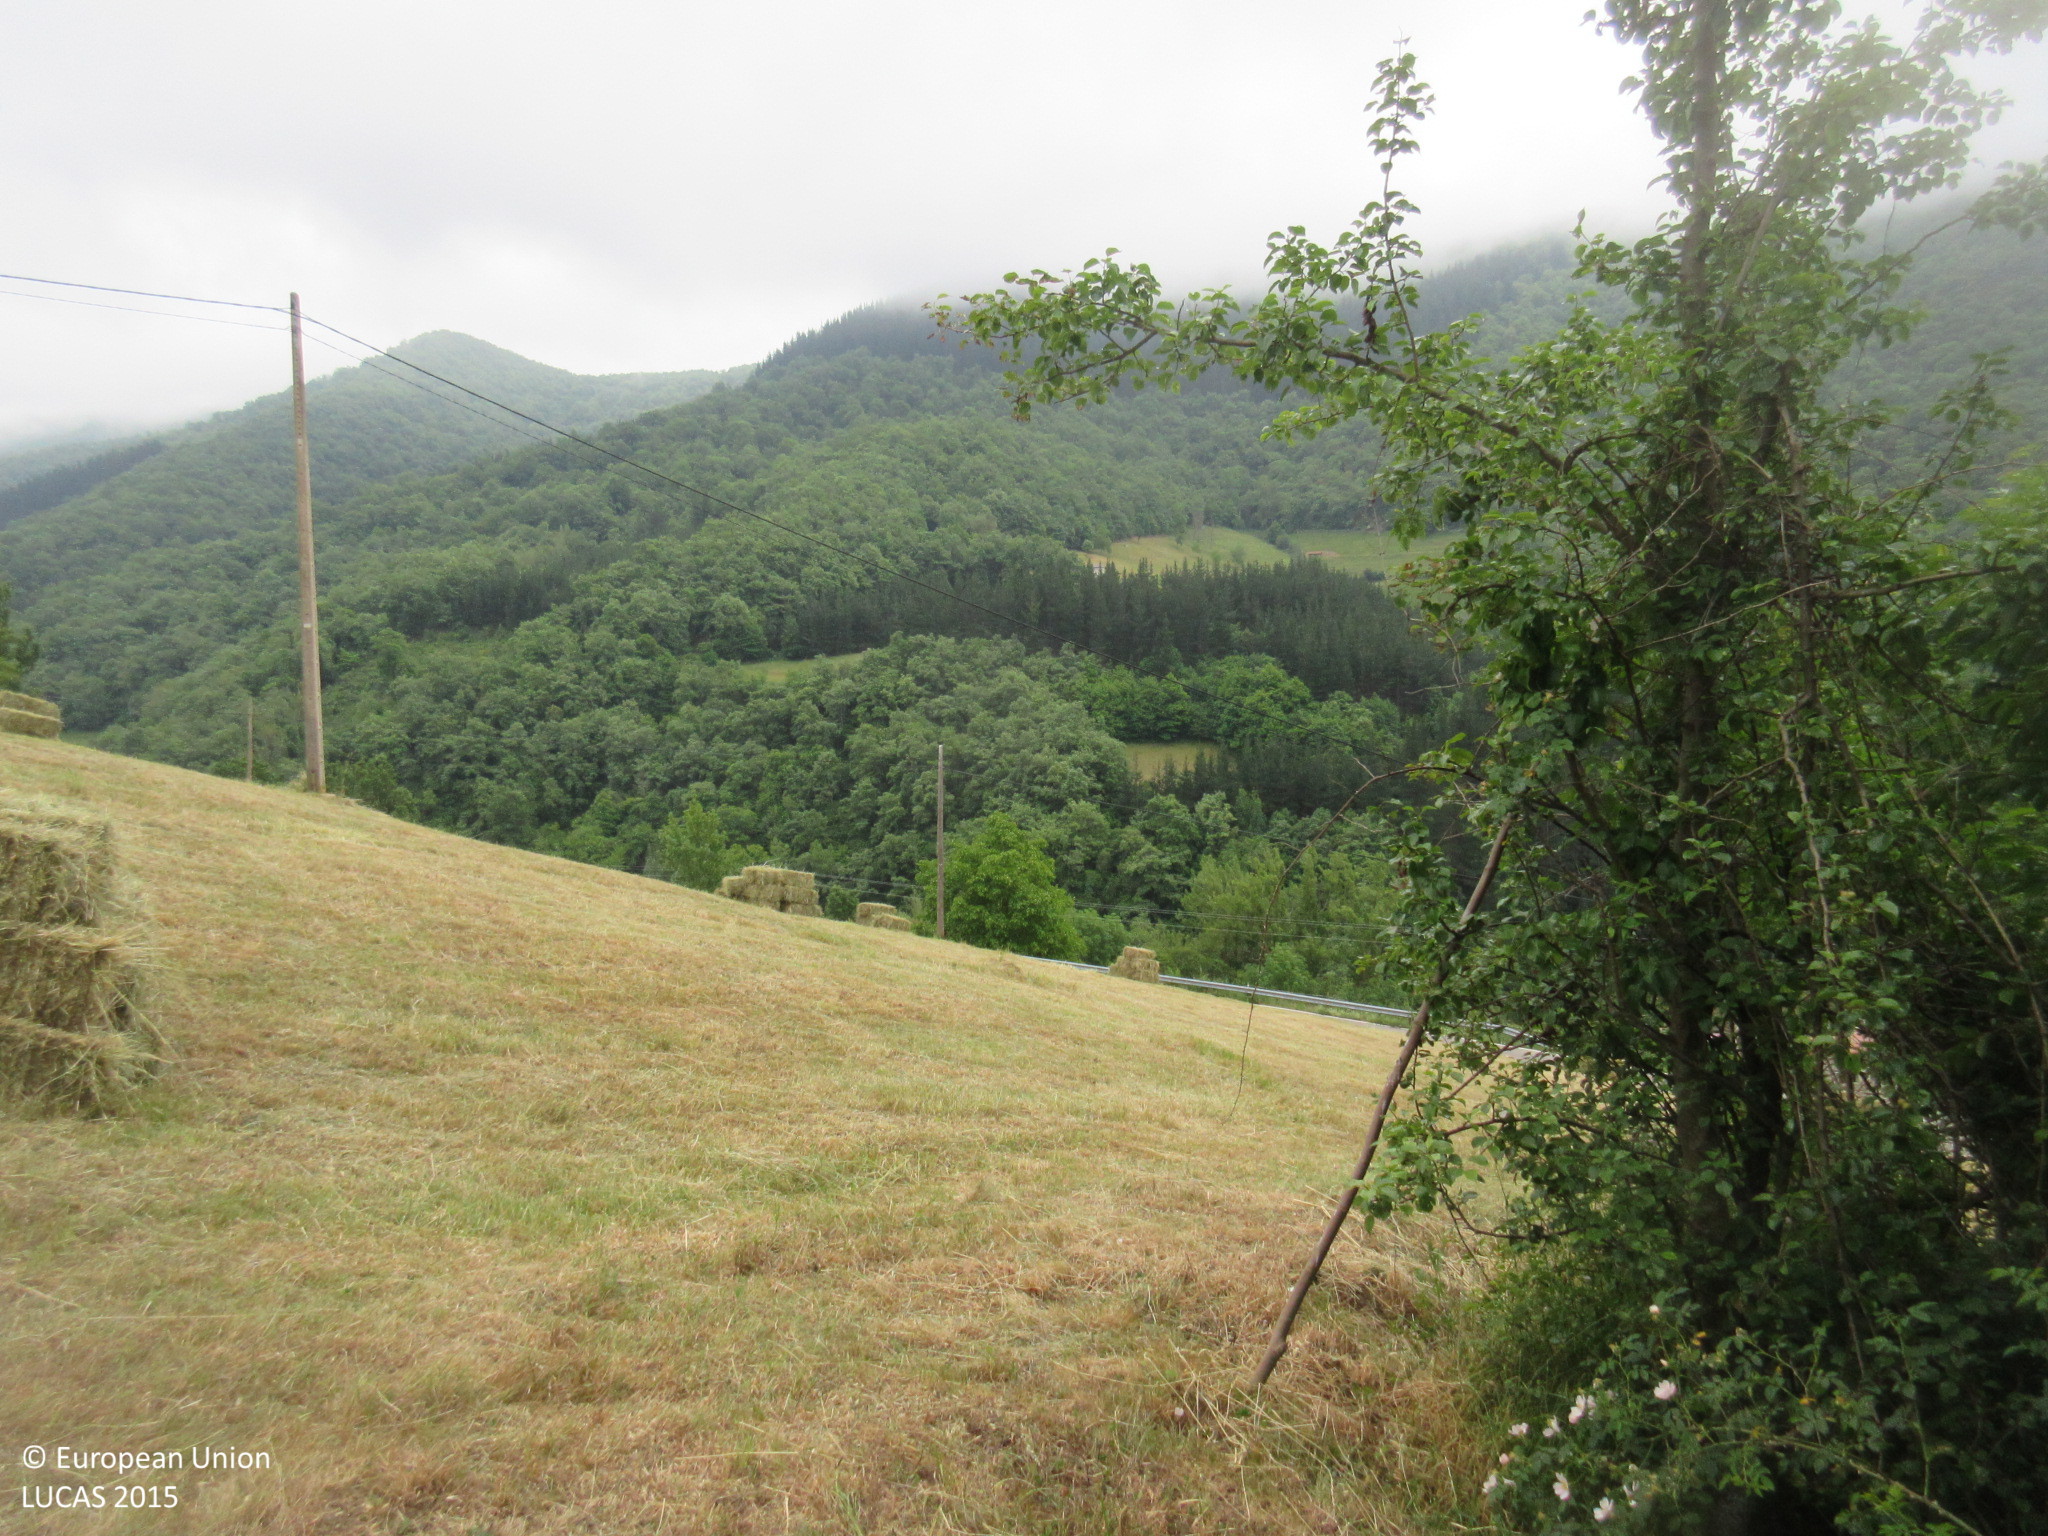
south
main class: Woodland
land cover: Broadleaved woodland
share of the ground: > 75 %
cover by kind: broadleaved forest trees 75 %, shrubs 25 %
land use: Semi-natural and natural areas not in use
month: June
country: ES
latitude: 43.1527
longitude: -4.5576
